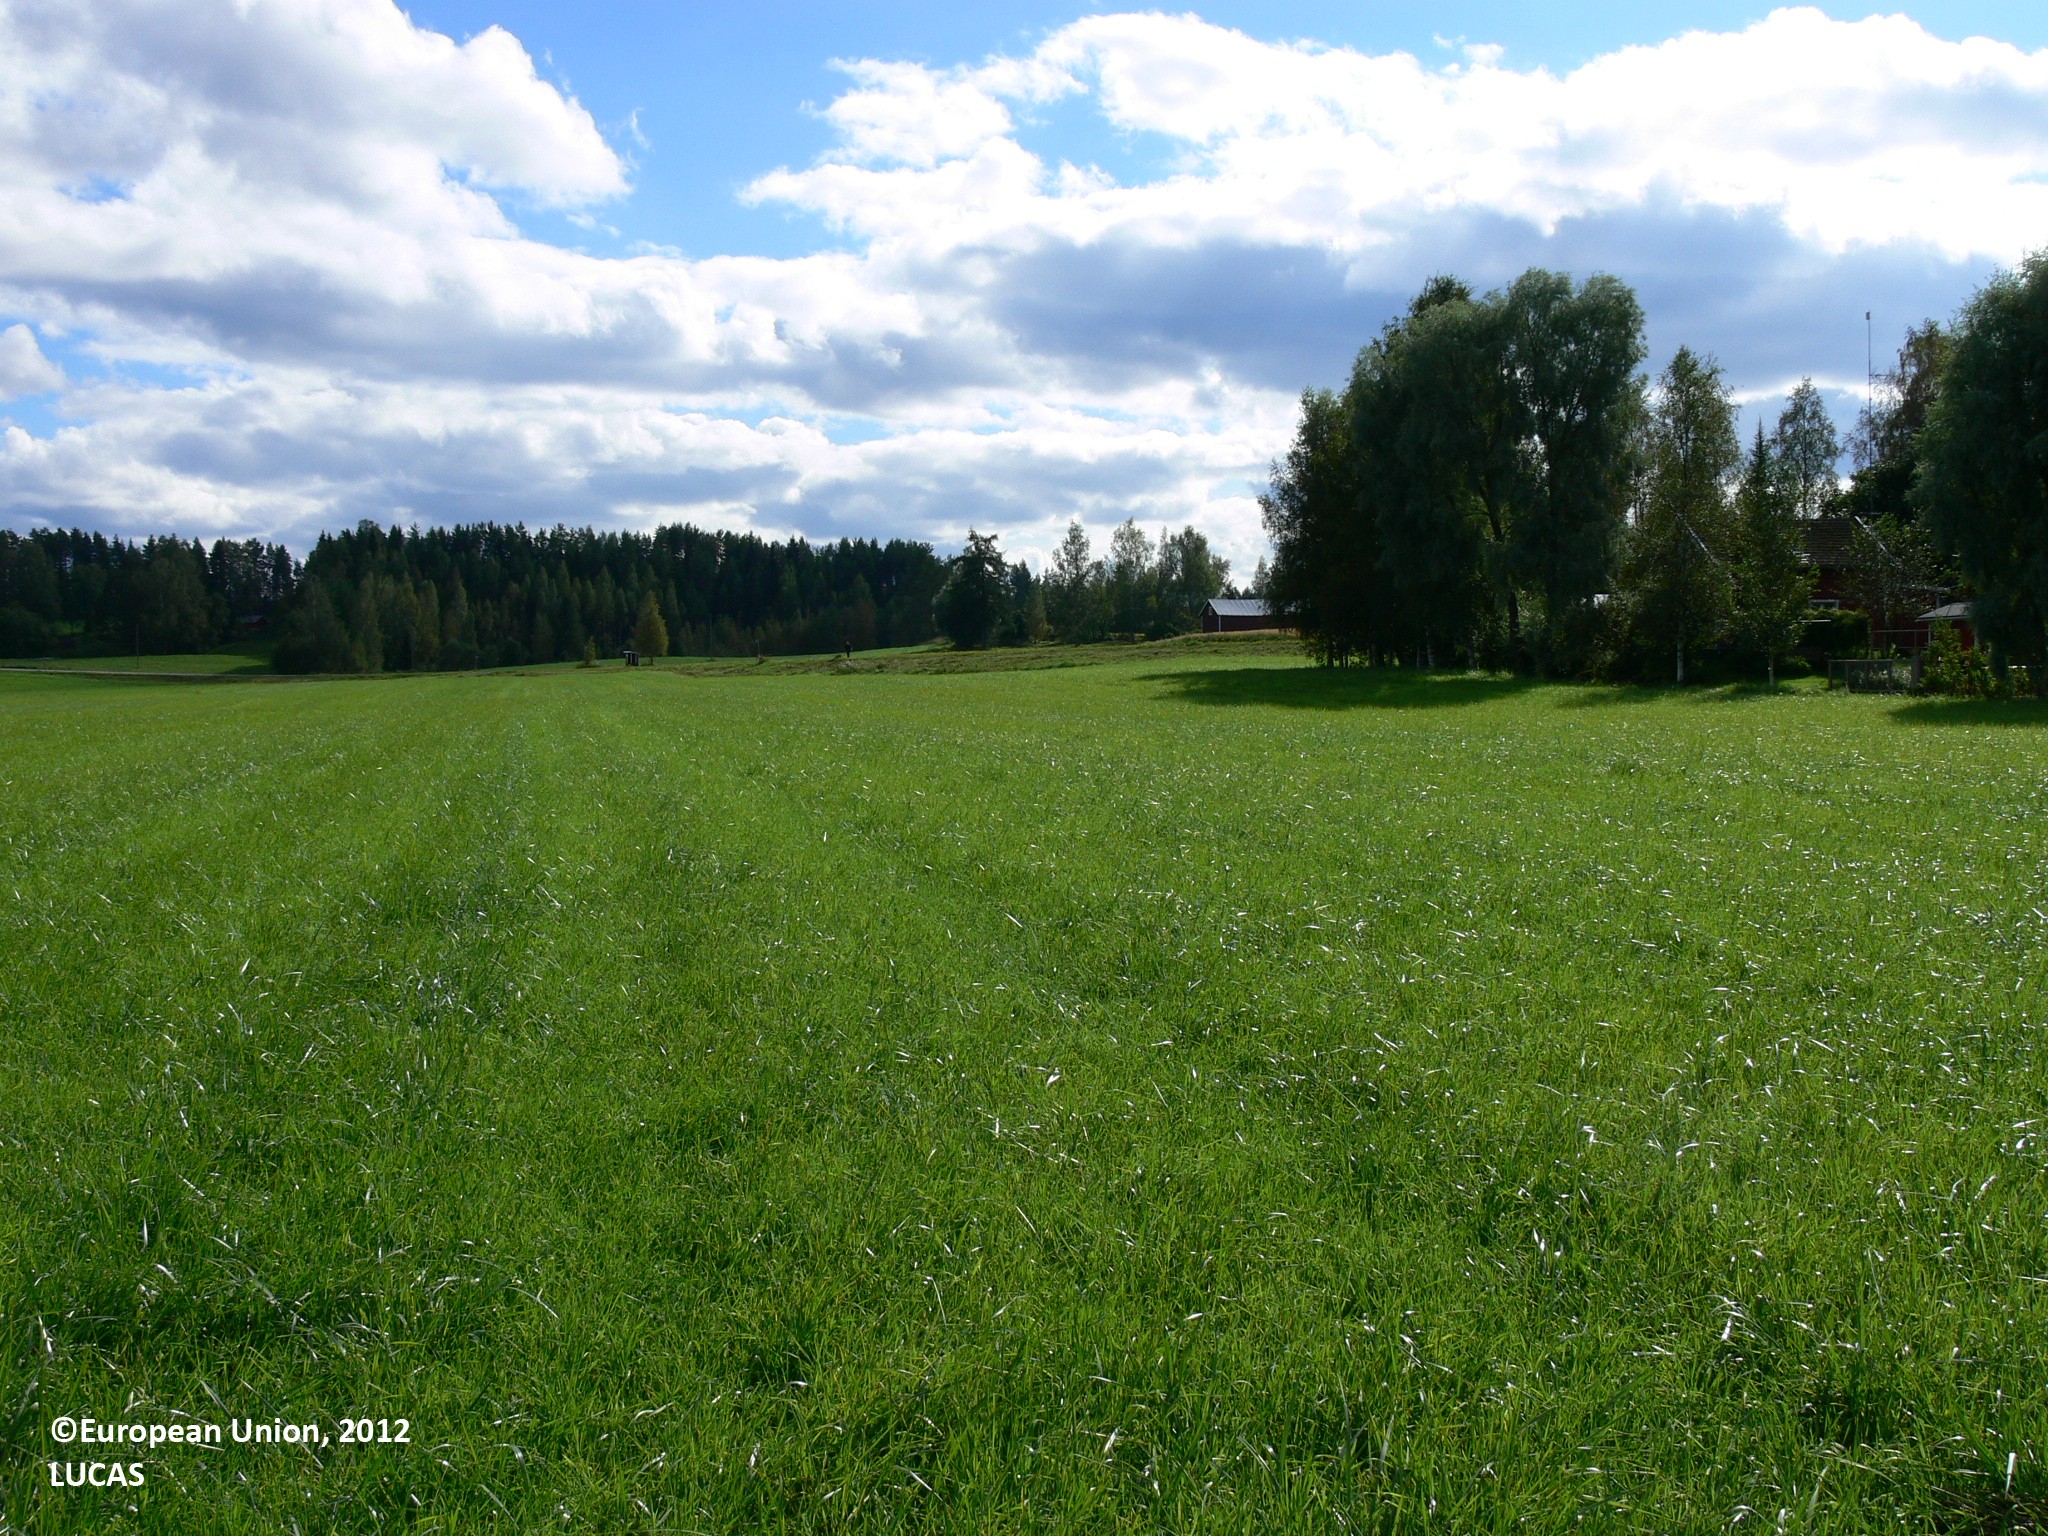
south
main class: Cropland
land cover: Temporary grasslands
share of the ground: > 75 %
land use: Agriculture (excluding fallow land and kitchen gardens)
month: August
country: FI
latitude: 62.0742
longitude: 30.2392
